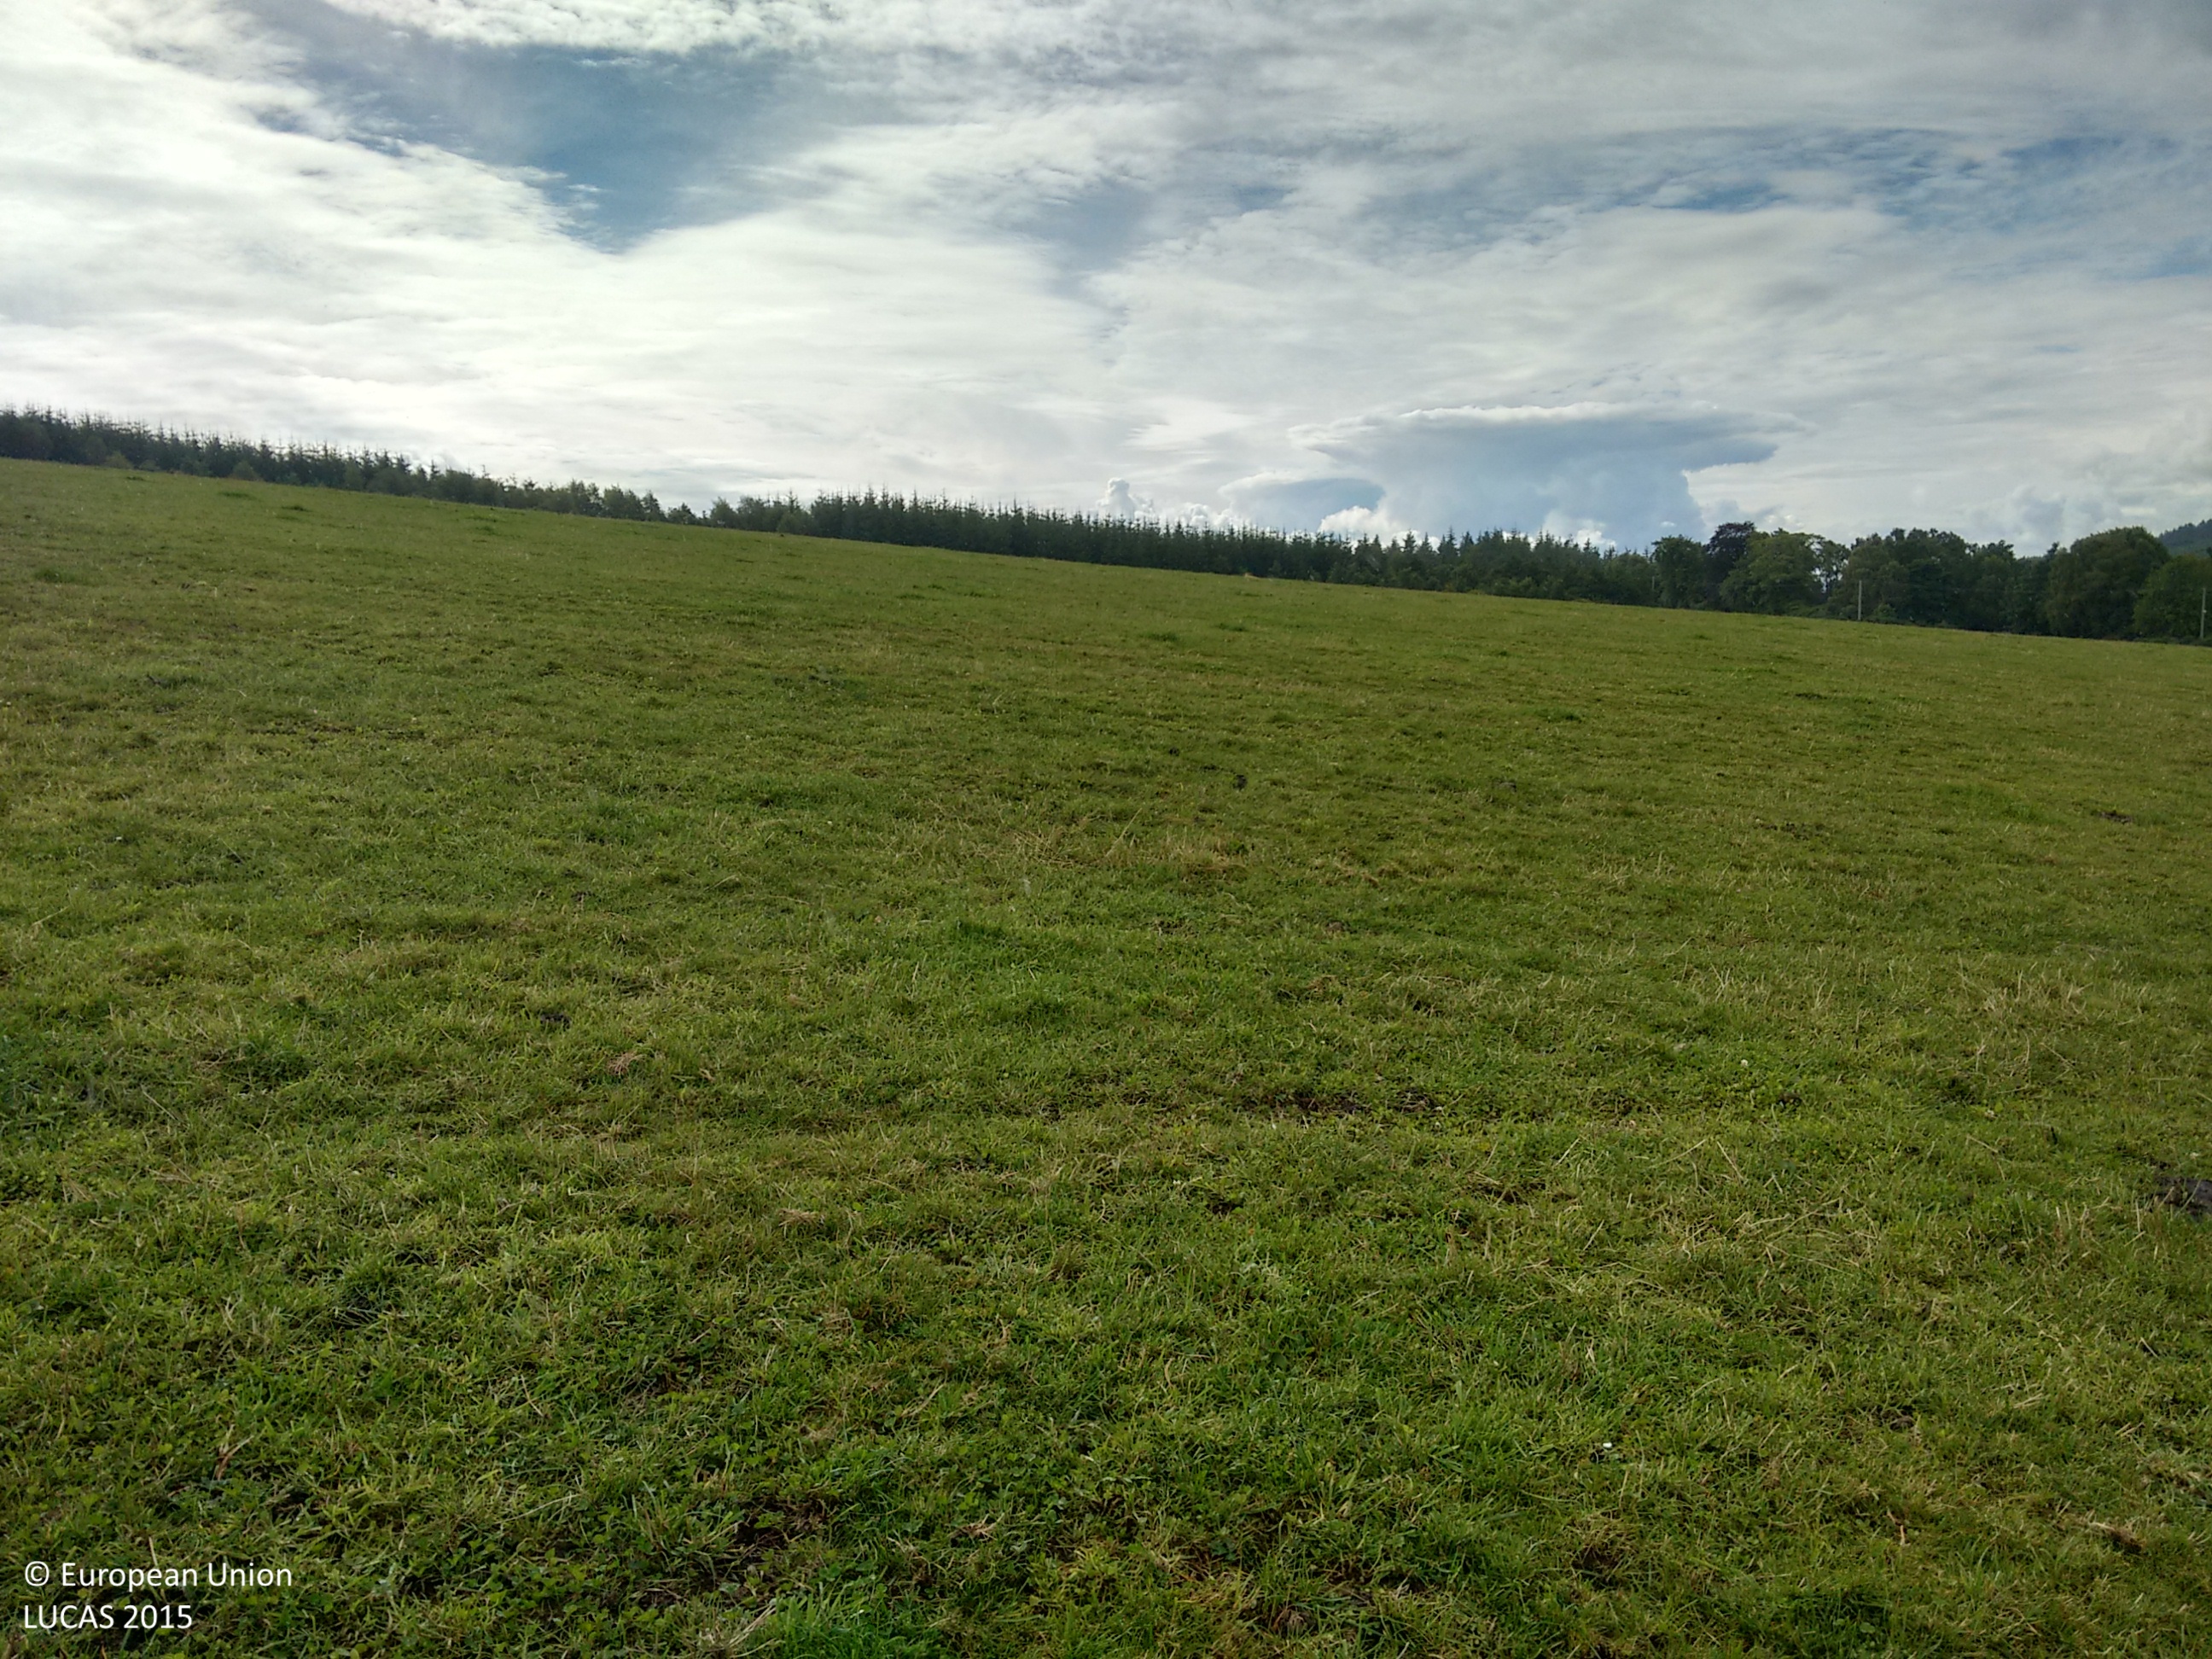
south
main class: Grassland
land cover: Grassland without tree/shrub cover
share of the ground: > 75 %
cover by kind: herbaceous plants 100 %
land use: Agriculture (excluding fallow land and kitchen gardens)
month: September
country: GB
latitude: 57.7267
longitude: -4.2736
